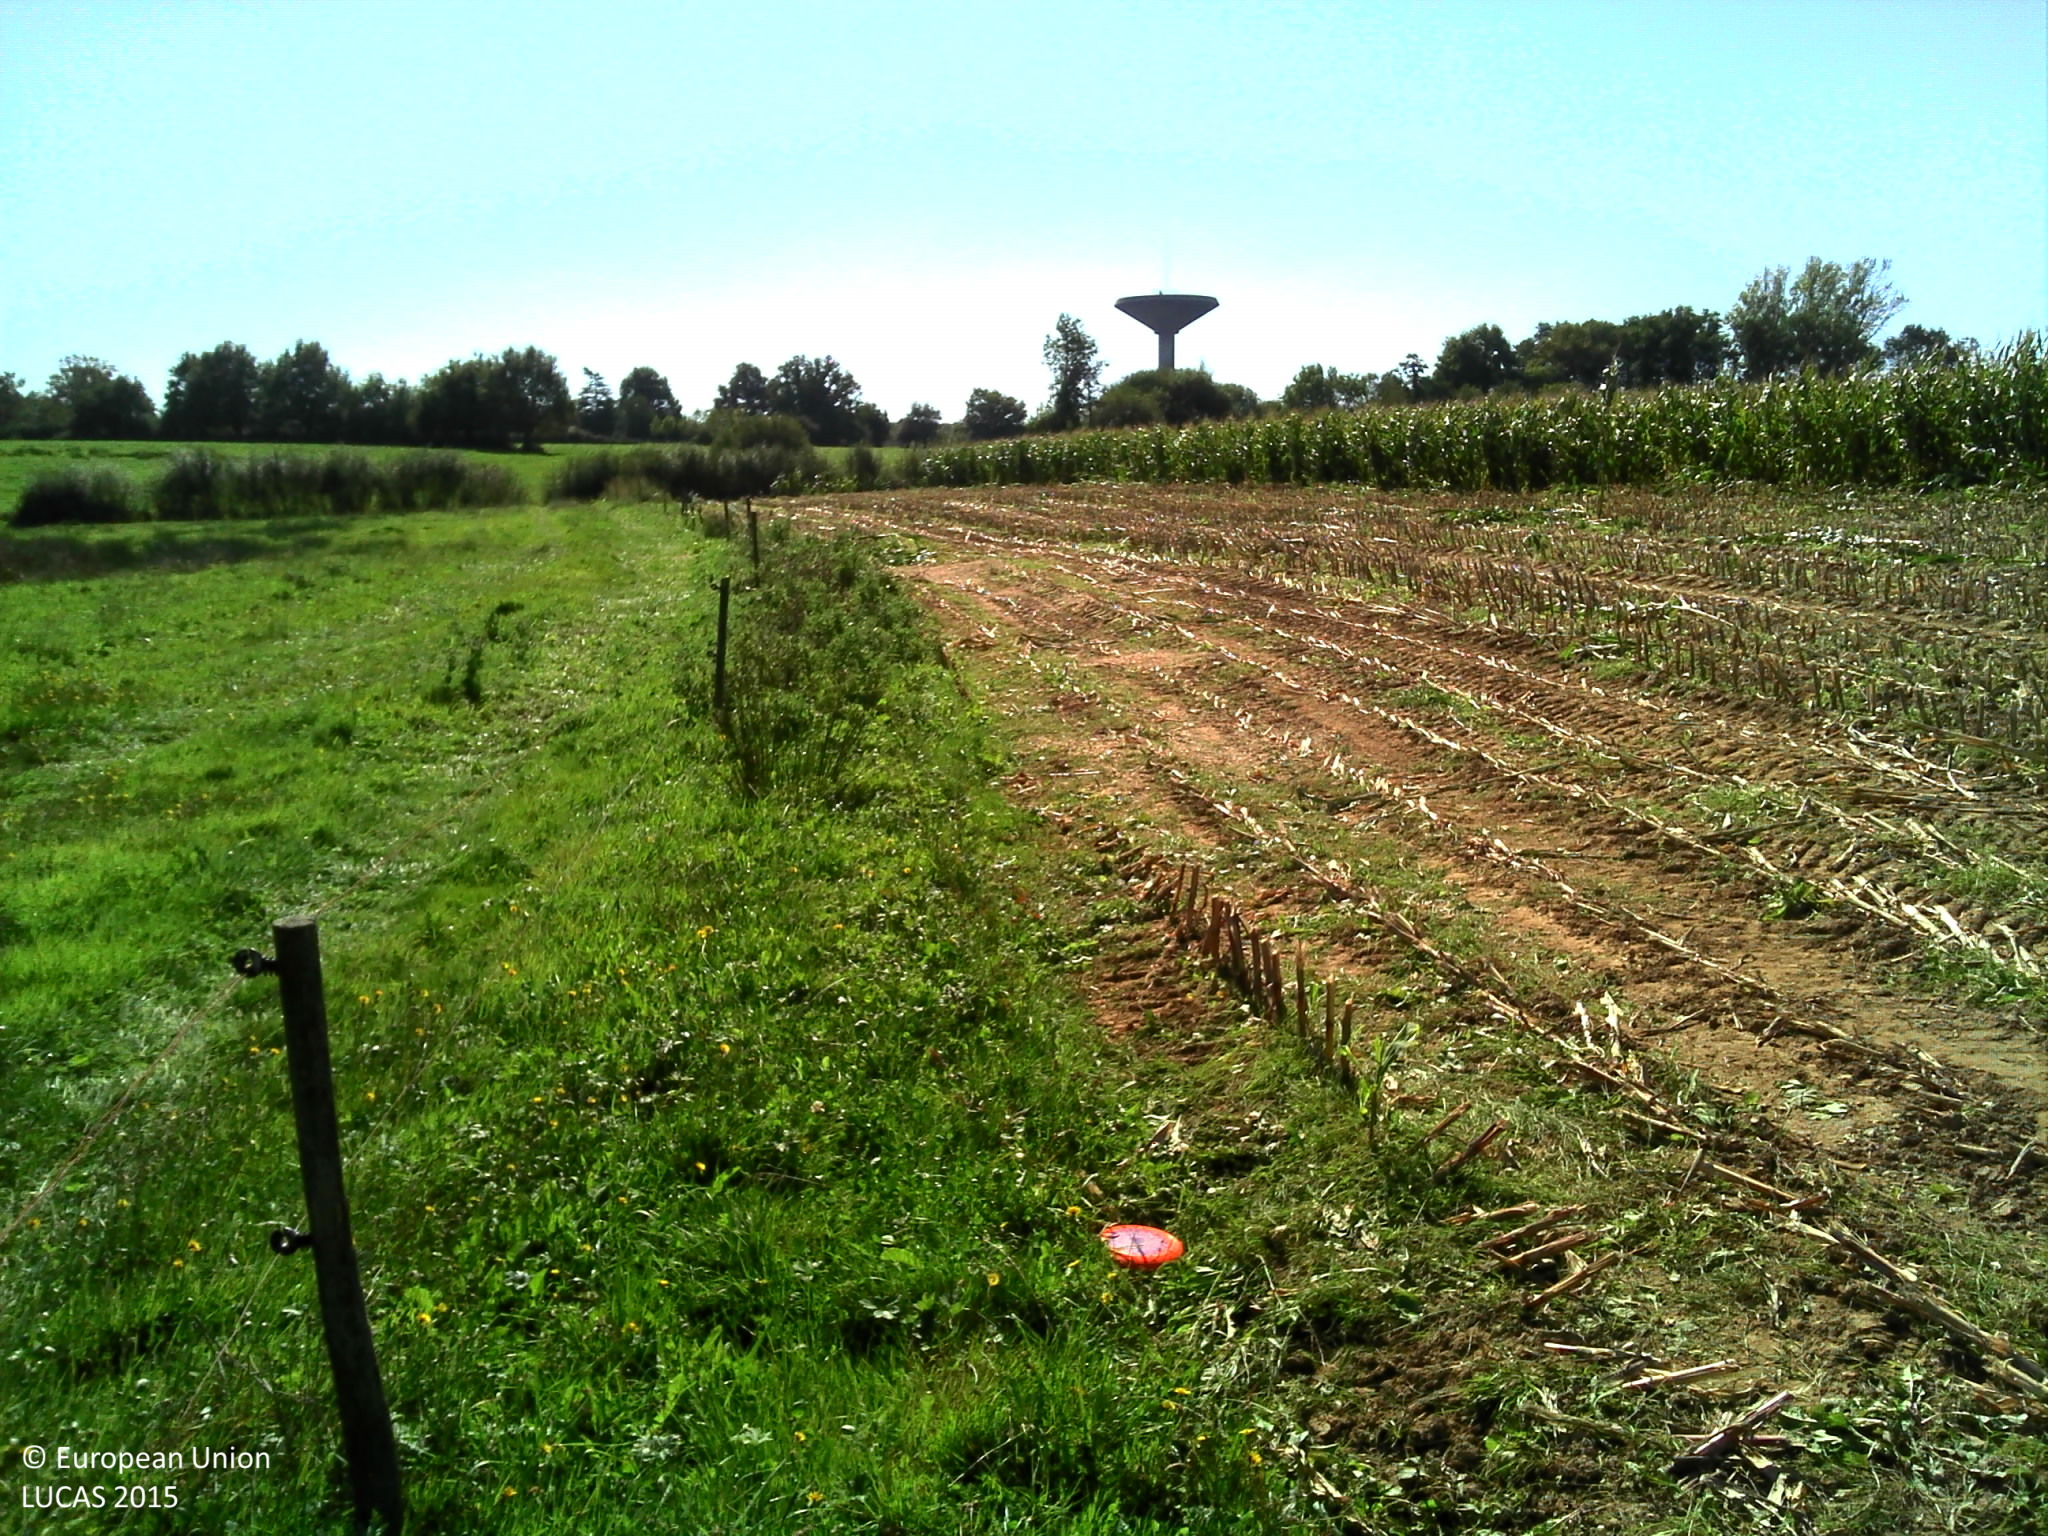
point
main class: Grassland
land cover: Grassland without tree/shrub cover
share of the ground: > 75 %
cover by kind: herbaceous plants 100 %
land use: Agriculture (excluding fallow land and kitchen gardens)
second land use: Amenities, museums, leisure
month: September
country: FR
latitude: 46.5689
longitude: -1.2950
